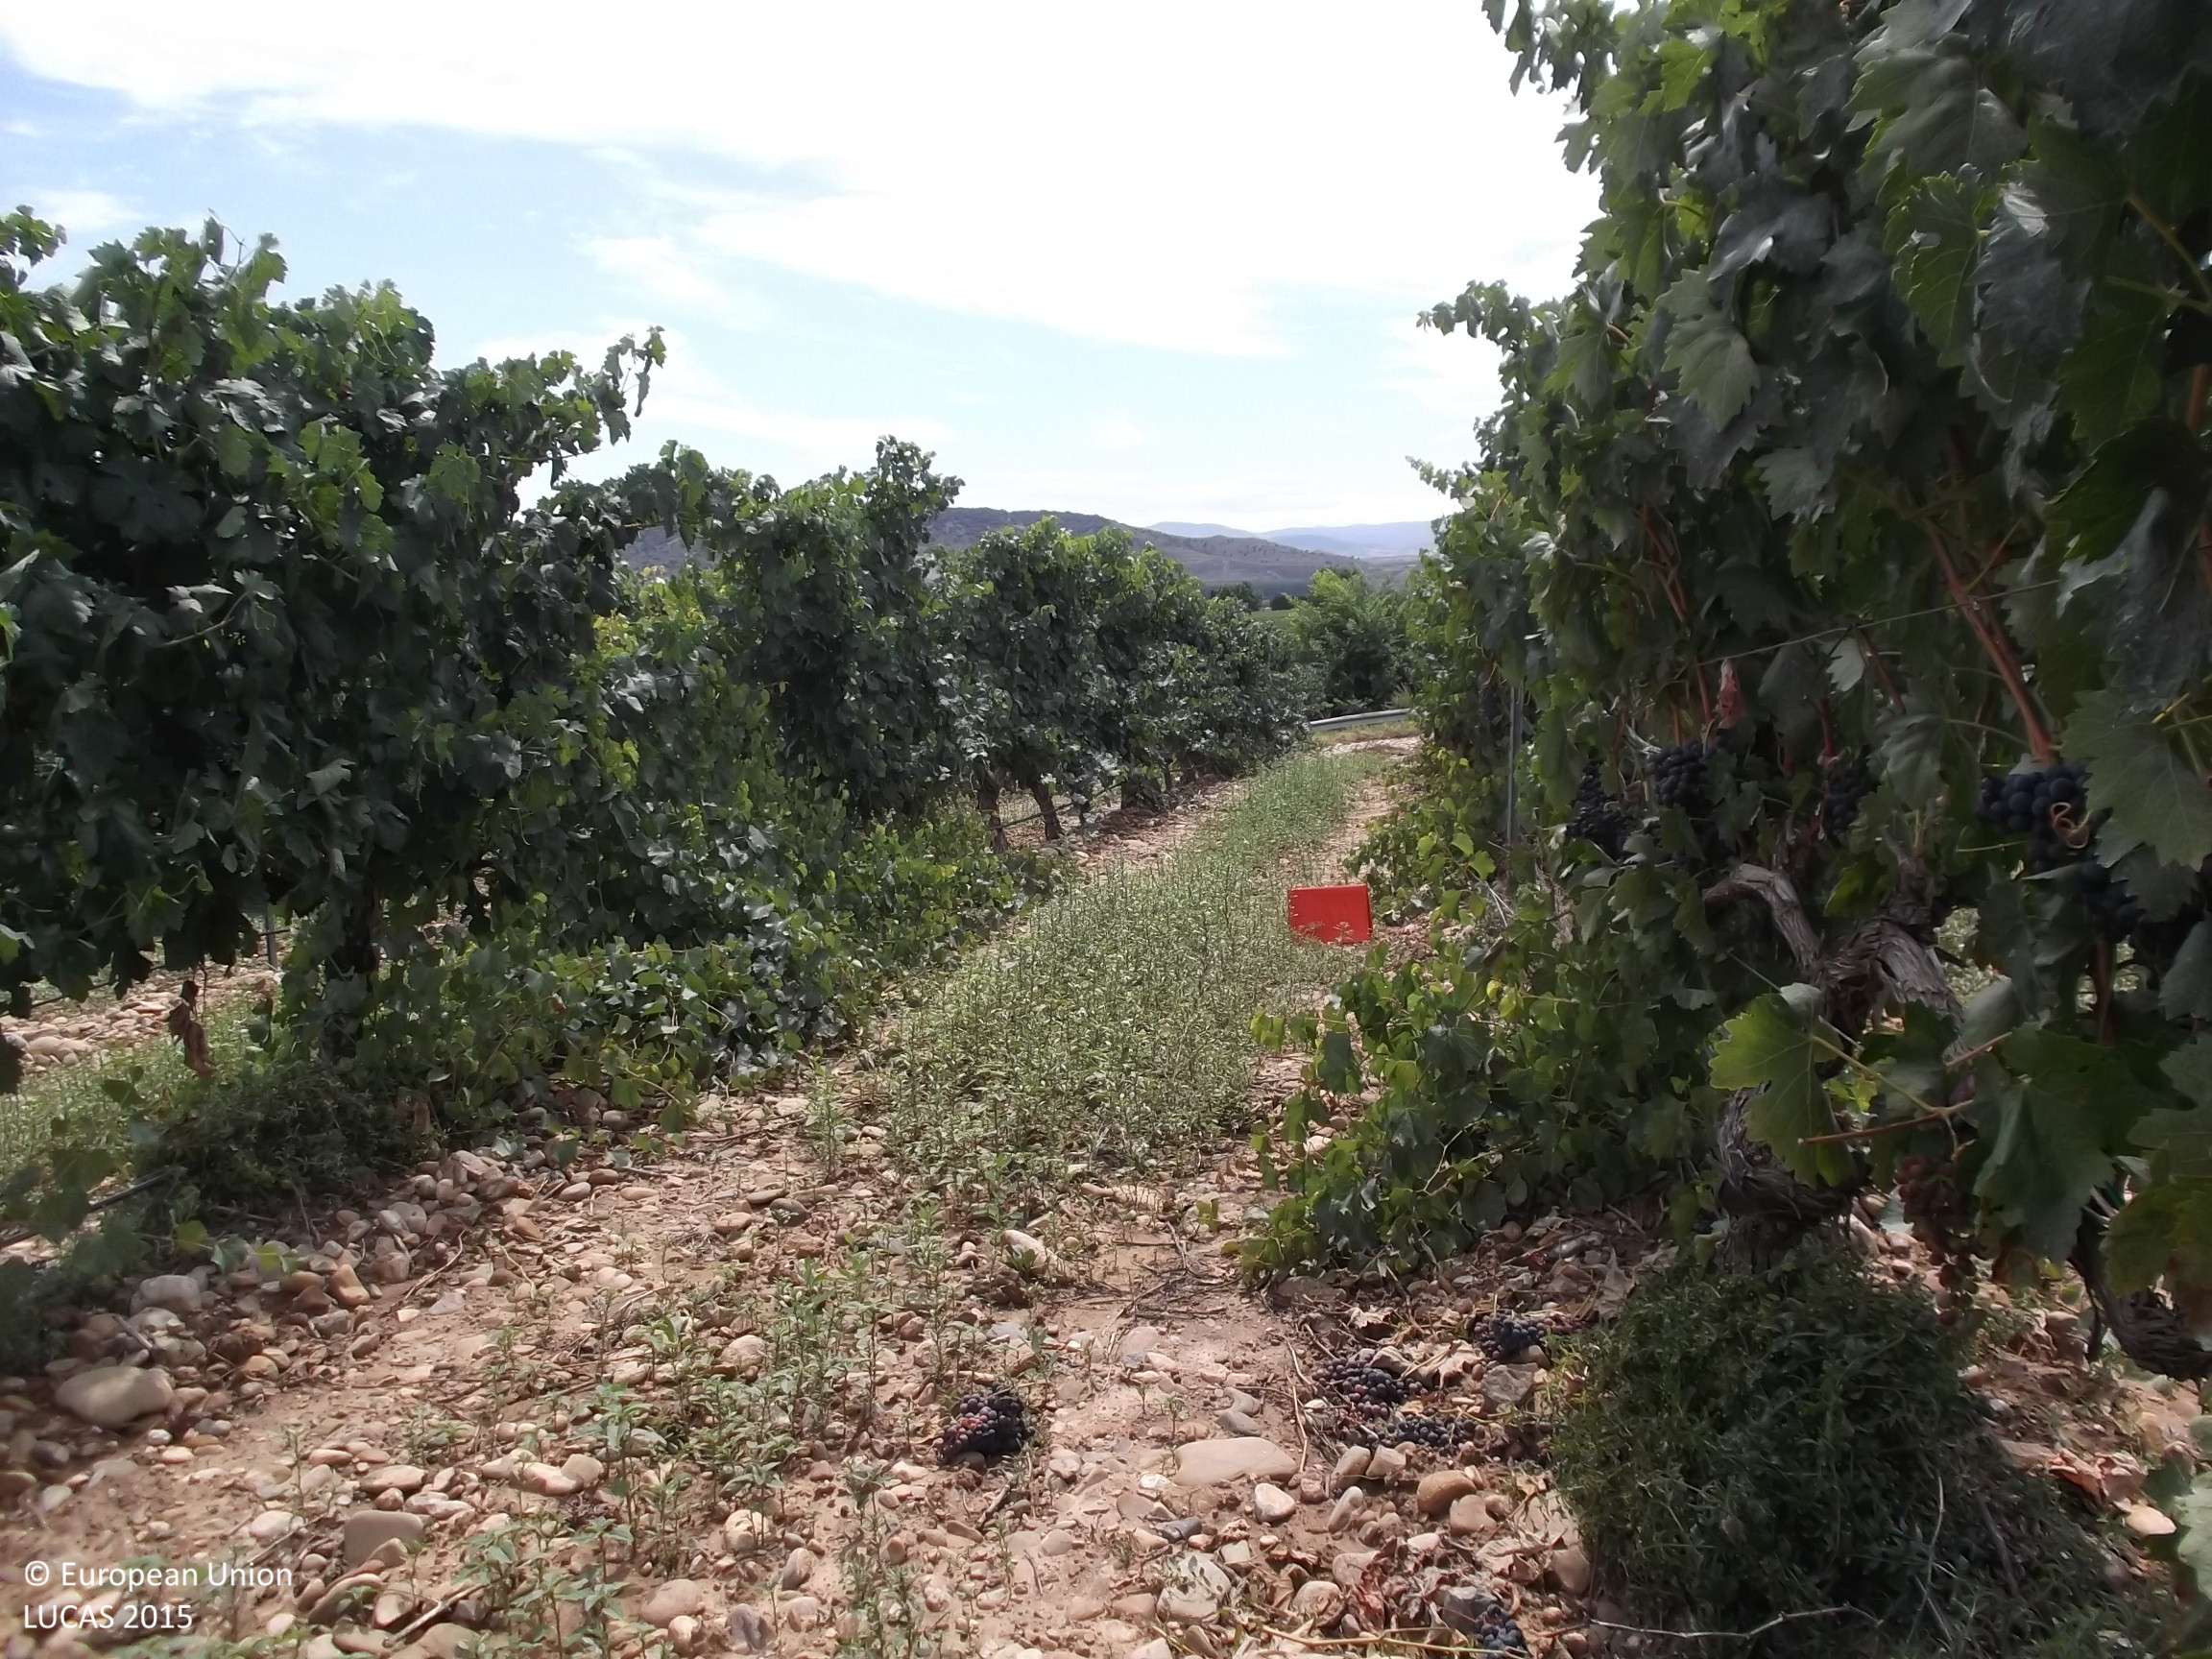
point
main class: Cropland
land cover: Vineyards
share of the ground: 10 - 25 %
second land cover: Other bare soil
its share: > 75 %
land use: Agriculture (excluding fallow land and kitchen gardens)
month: August
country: ES
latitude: 42.4293
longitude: -2.1595
